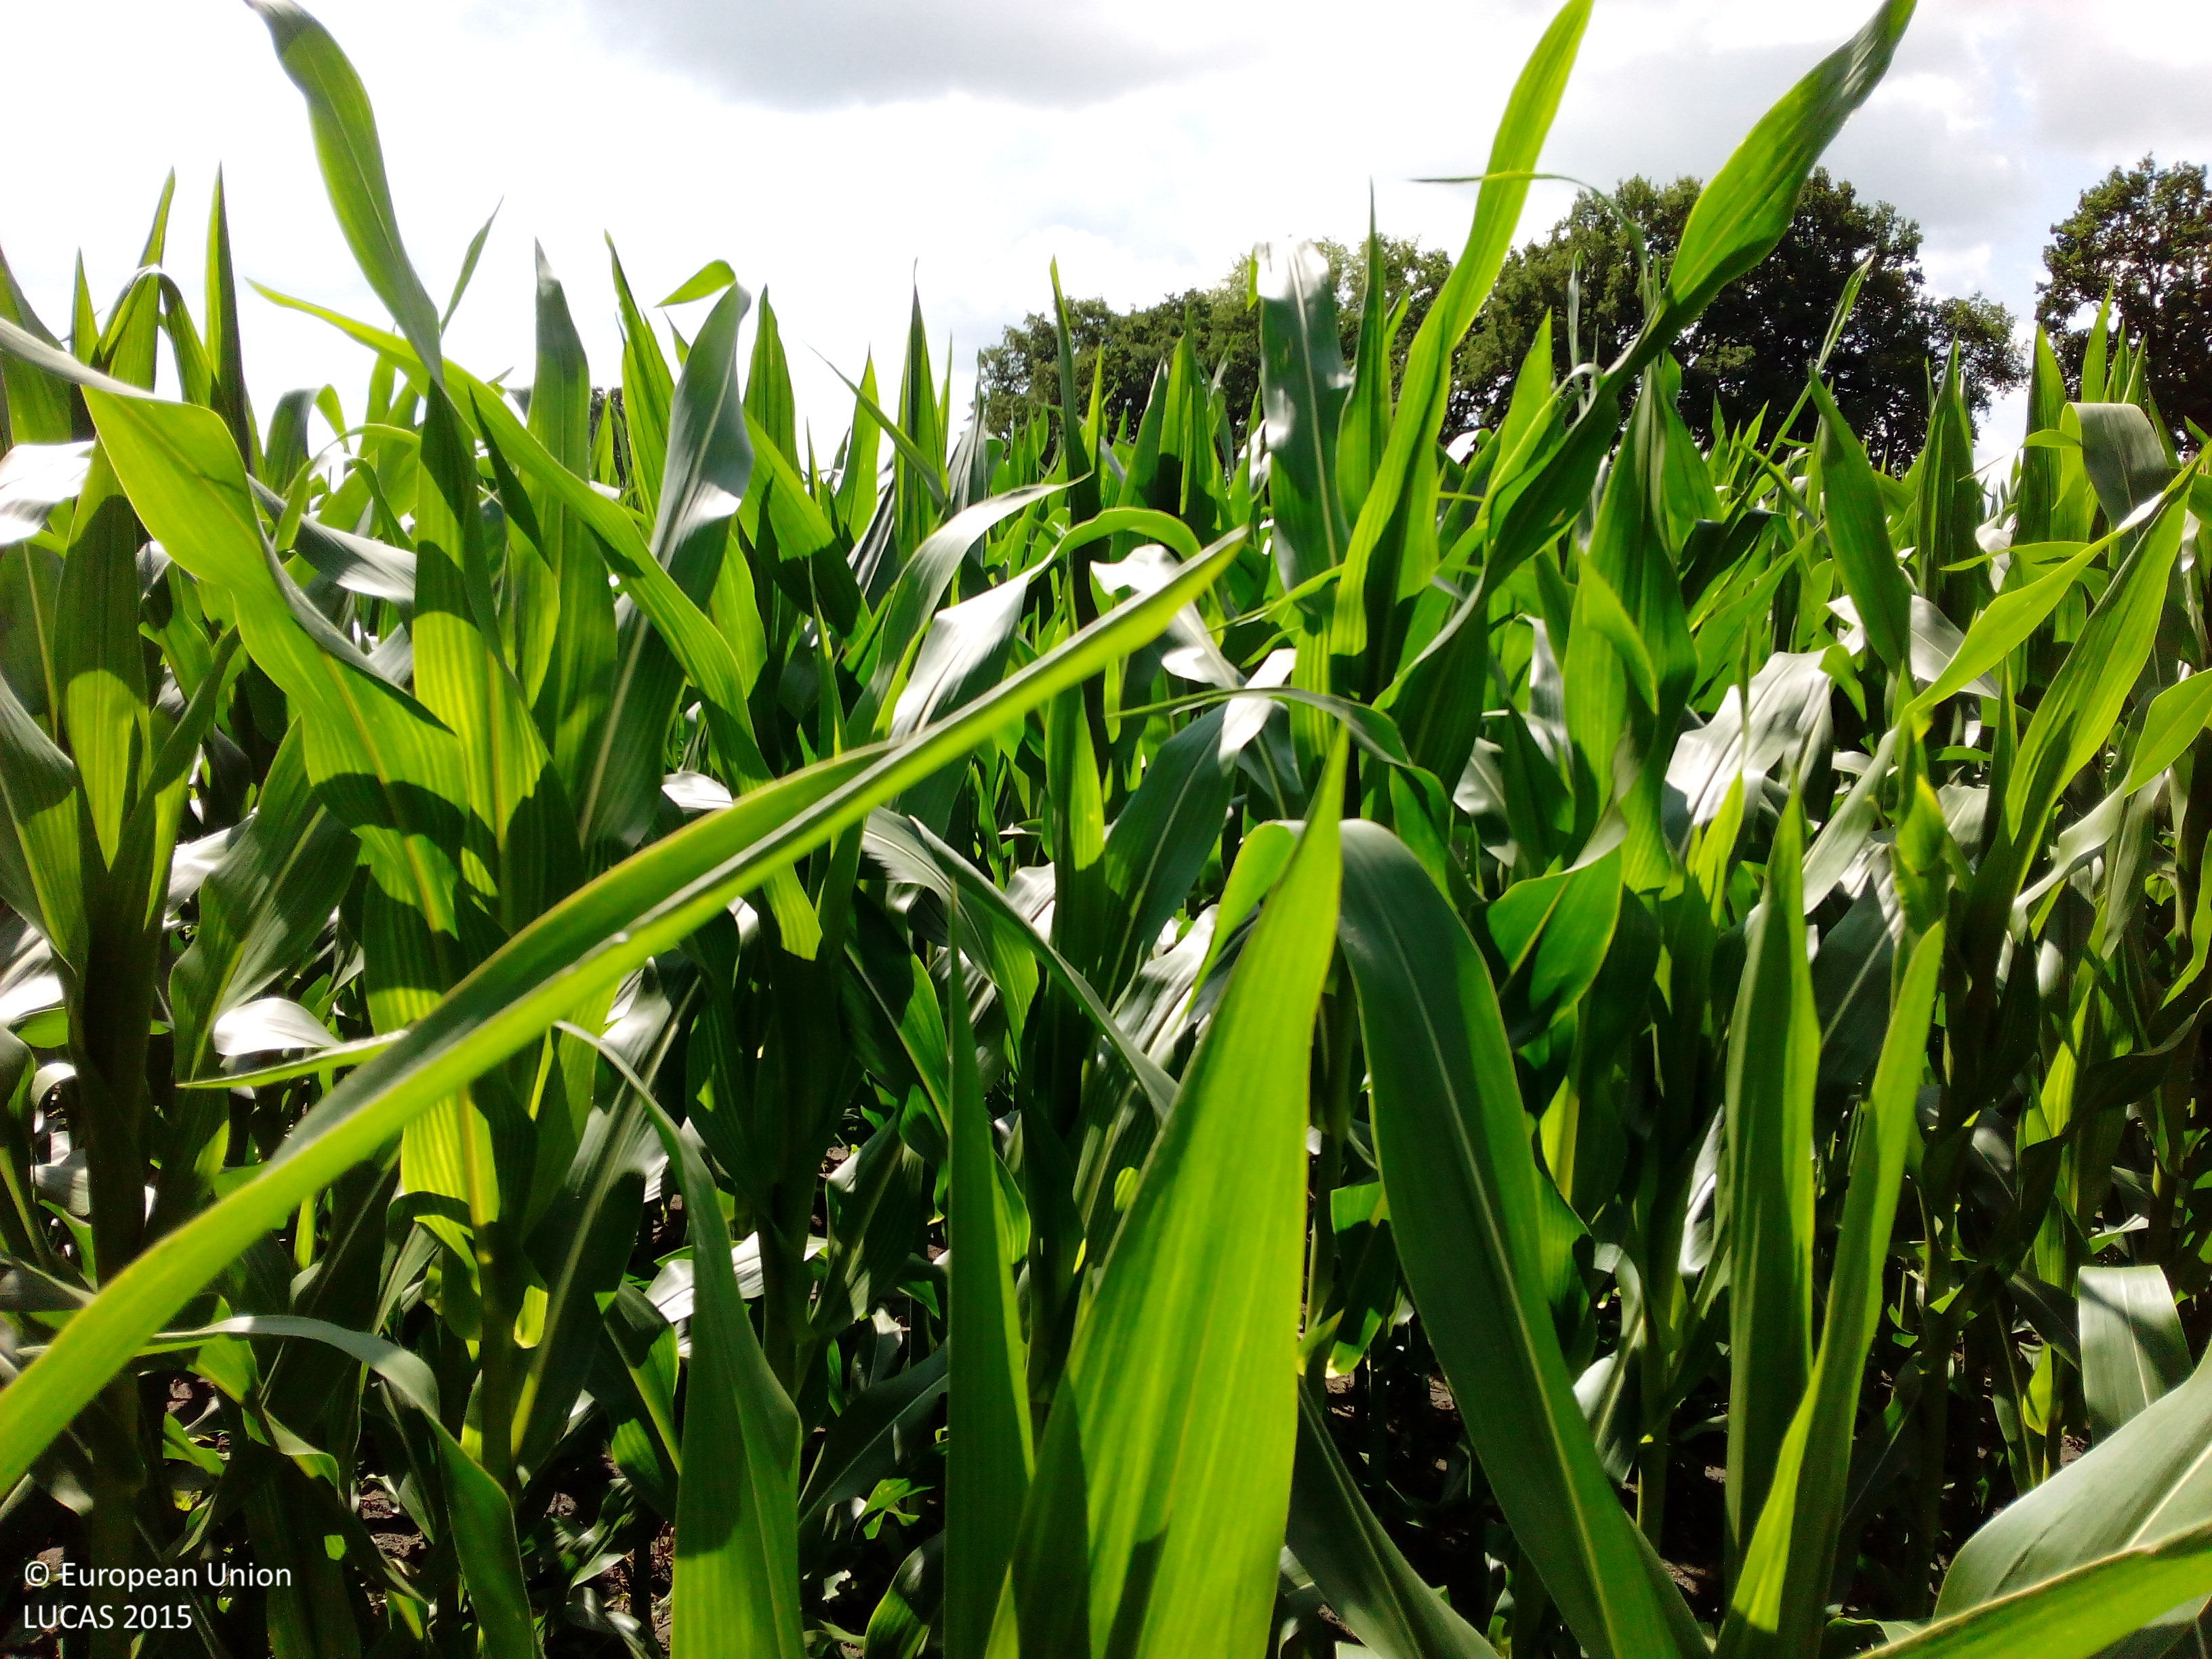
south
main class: Cropland
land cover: Maize
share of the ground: > 75 %
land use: Agriculture (excluding fallow land and kitchen gardens)
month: July
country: DE
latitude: 53.1324
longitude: 7.9231
